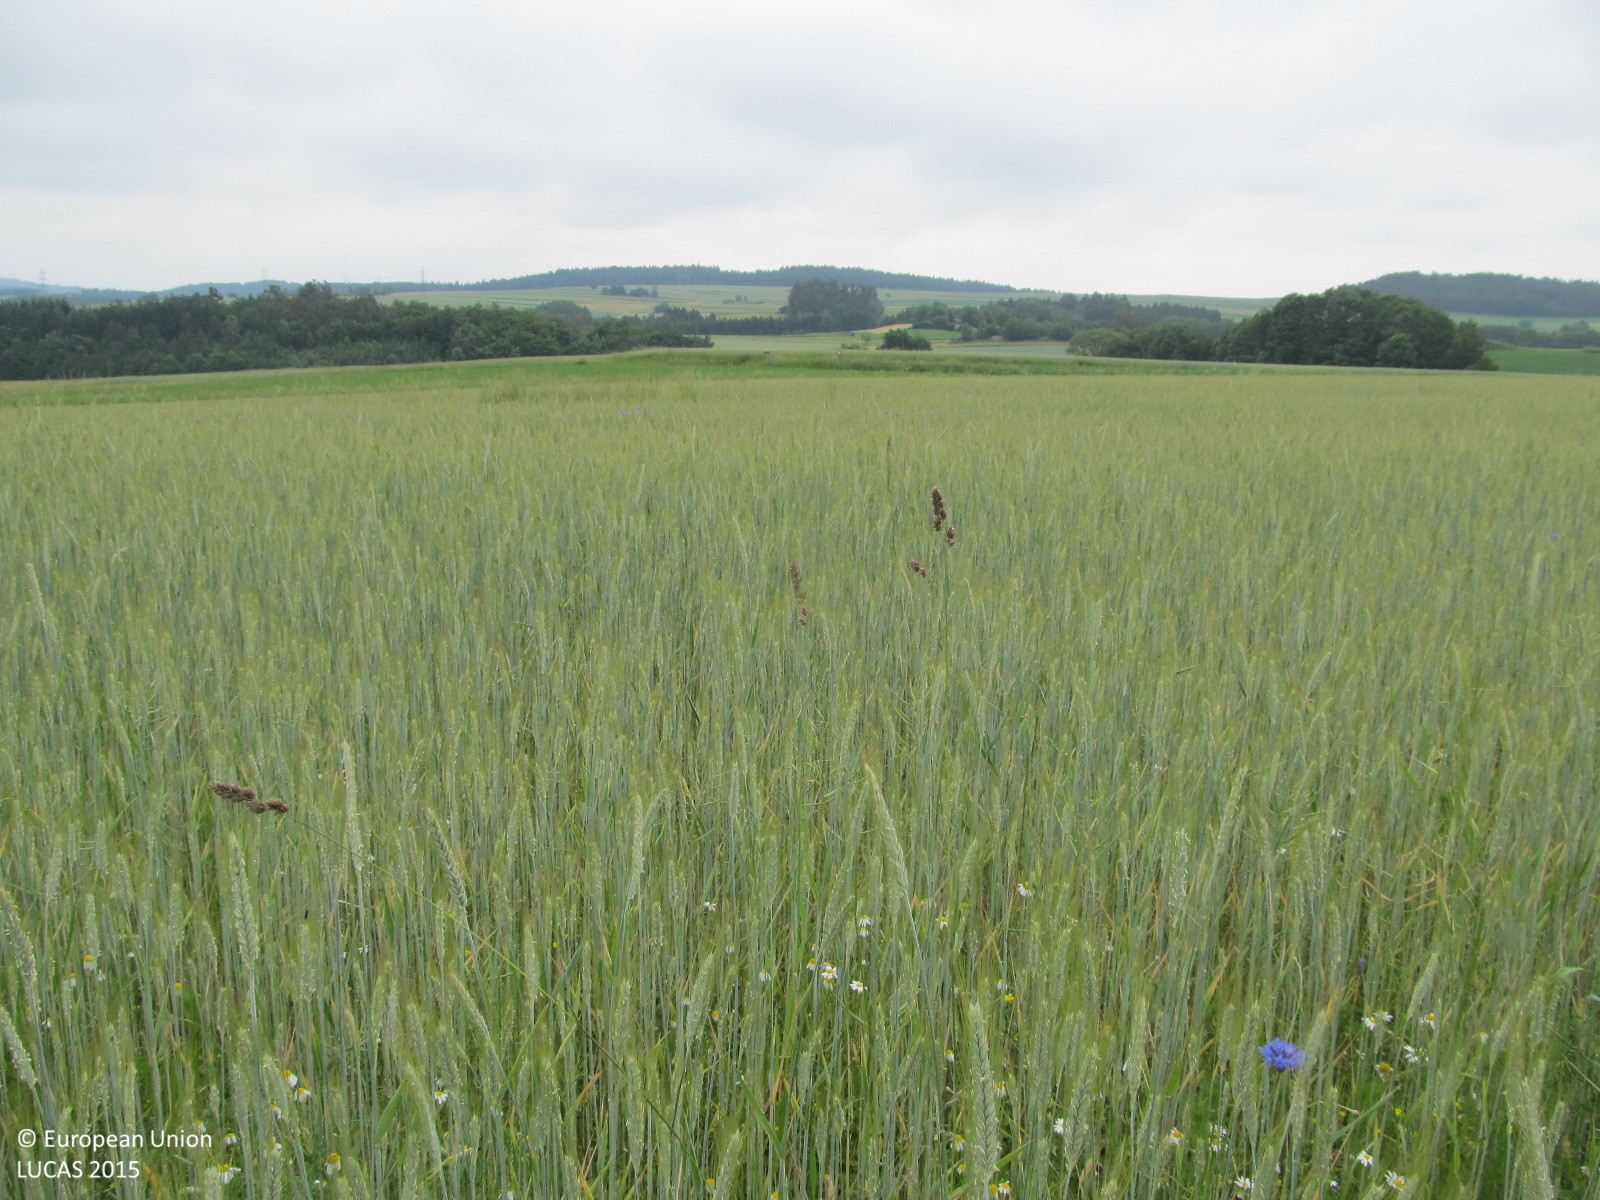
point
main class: Cropland
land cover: Rye
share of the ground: > 75 %
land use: Agriculture (excluding fallow land and kitchen gardens)
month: June
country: AT
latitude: 48.5749
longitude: 15.4649
